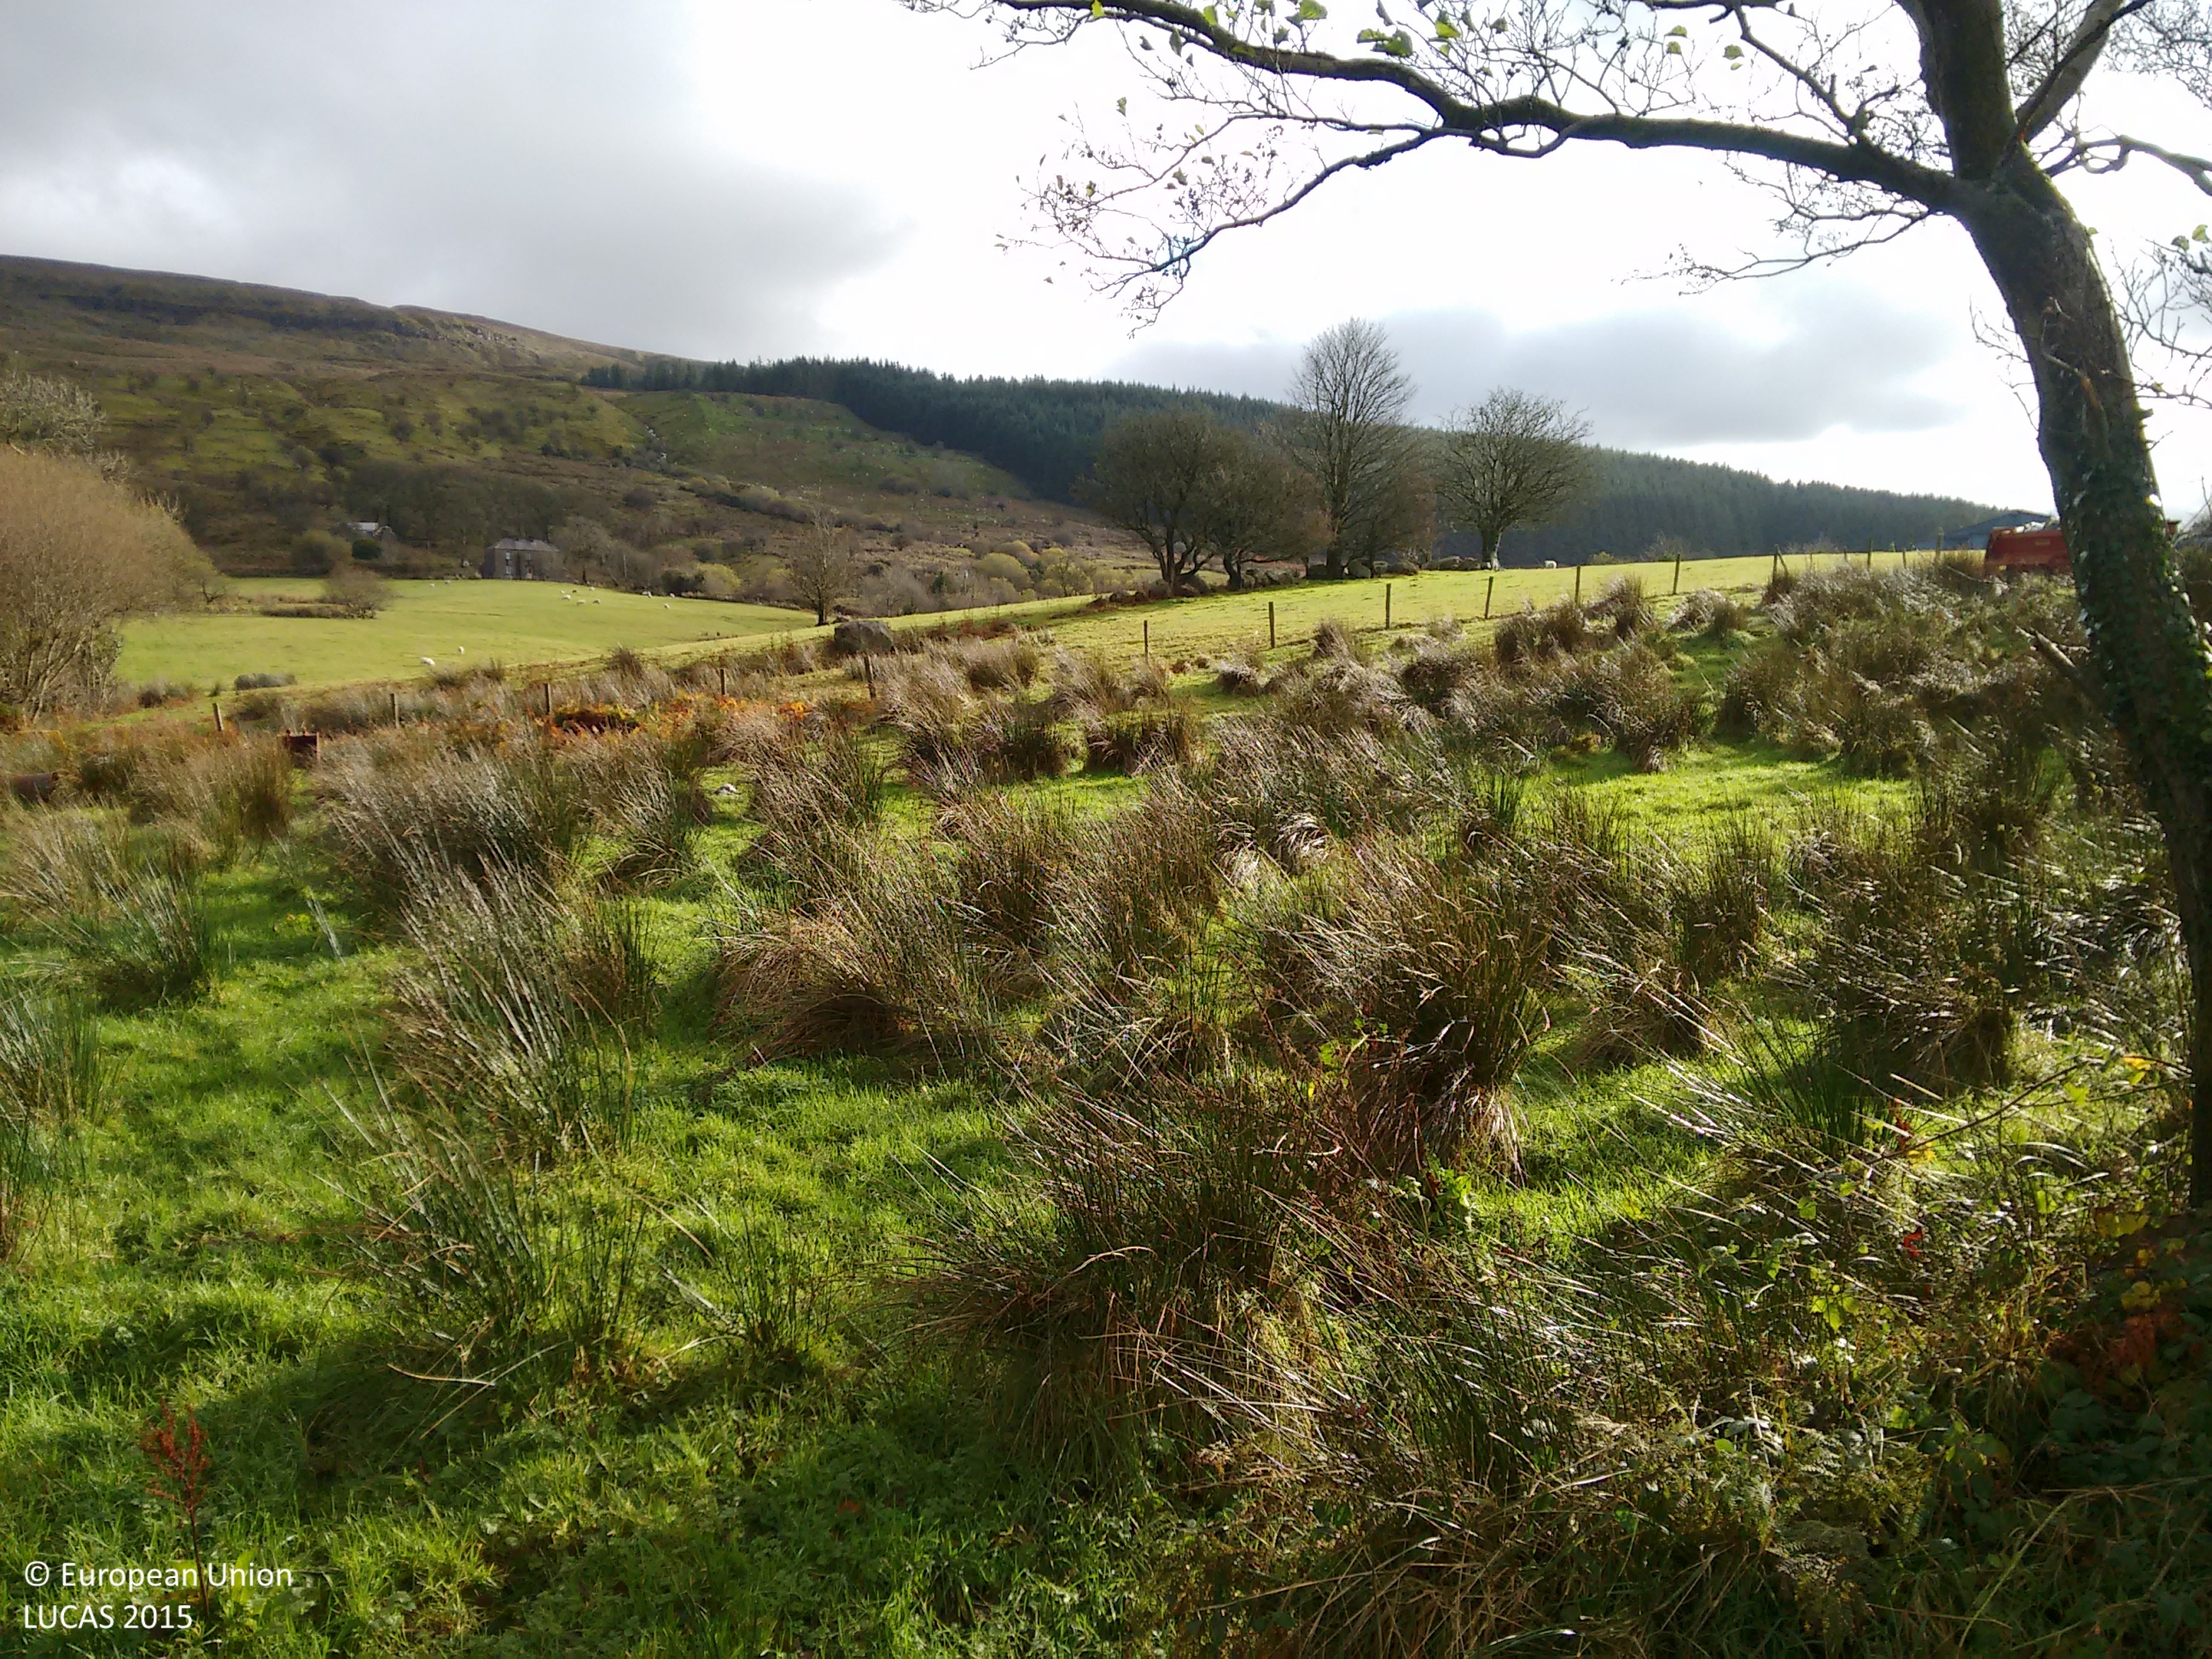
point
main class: Grassland
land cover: Grassland without tree/shrub cover
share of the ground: > 75 %
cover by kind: herbaceous plants 100 %
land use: Agriculture (excluding fallow land and kitchen gardens)
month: November
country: IE
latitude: 54.1006
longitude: -8.0211
